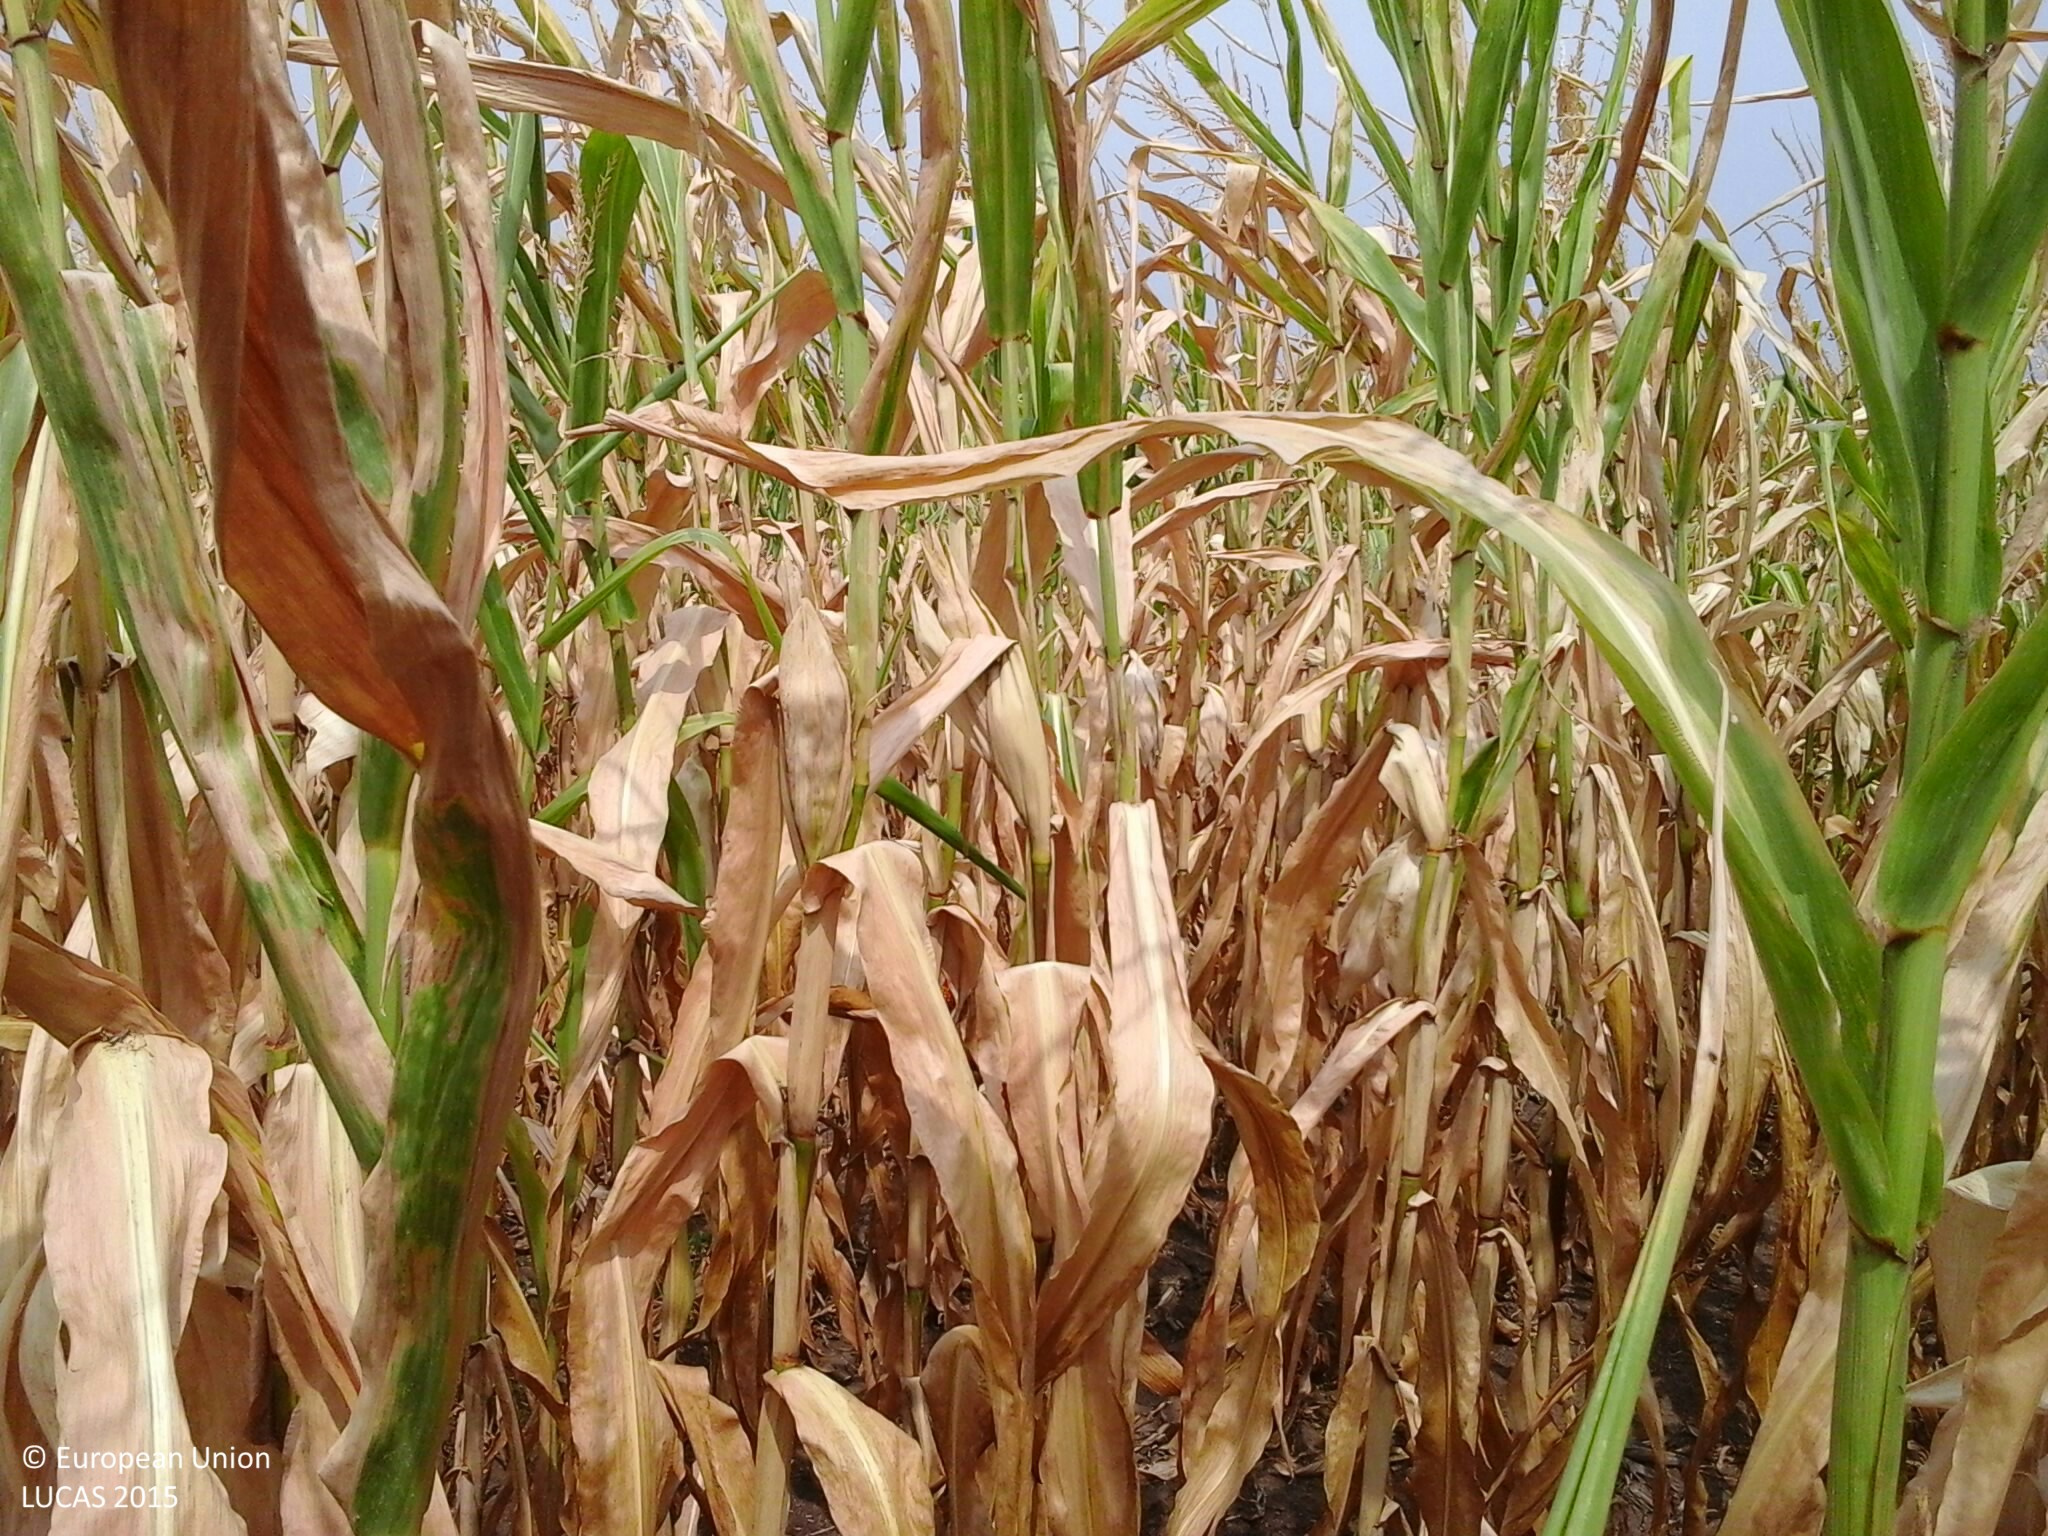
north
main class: Cropland
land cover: Maize
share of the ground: > 75 %
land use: Agriculture (excluding fallow land and kitchen gardens)
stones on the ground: < 10 %
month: August
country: HU
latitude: 47.7590
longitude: 20.2889
